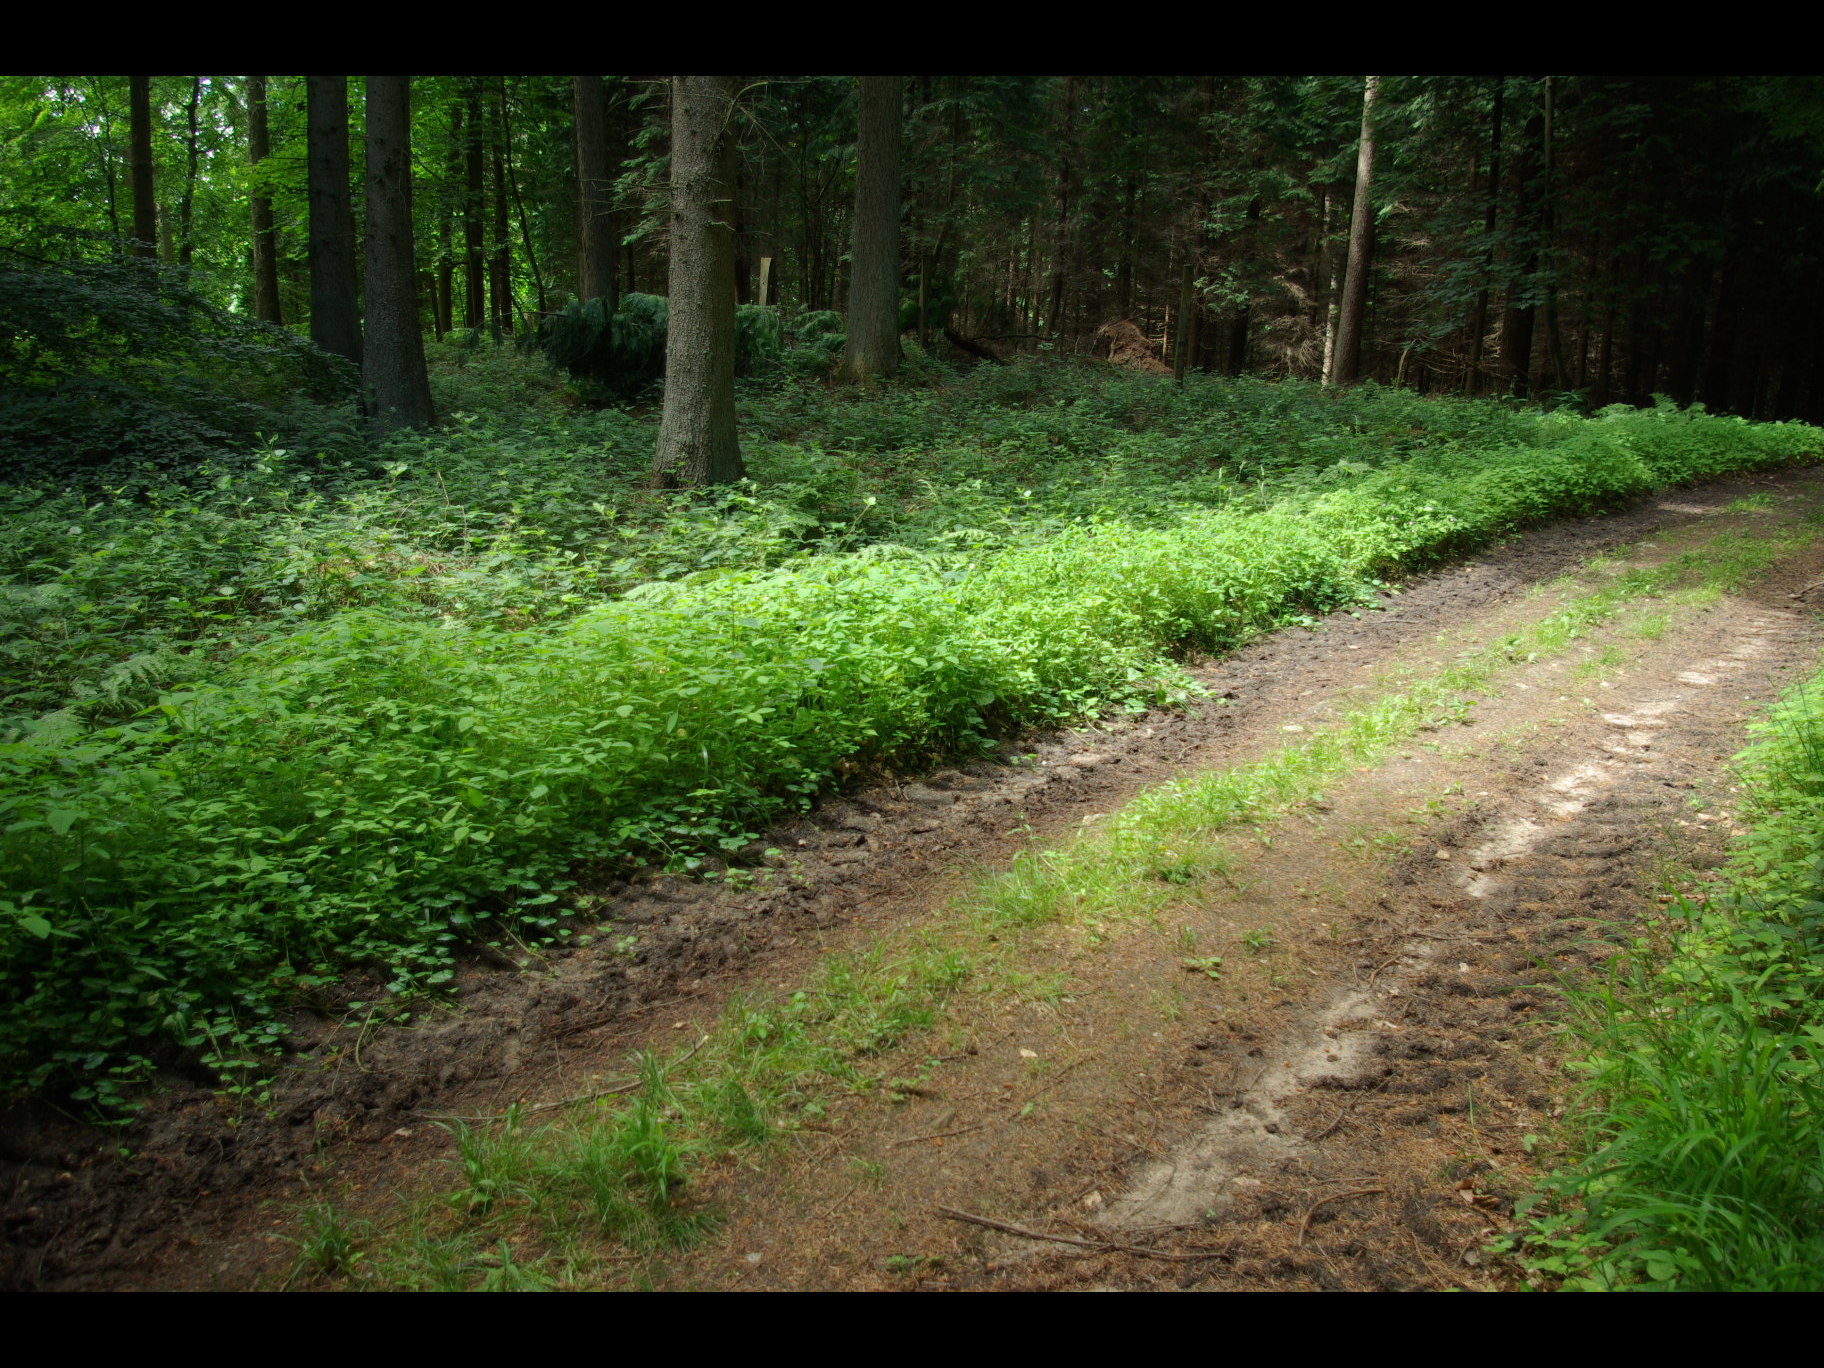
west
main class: Woodland
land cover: Other mixed woodland
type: hemiboreal forest and nemoral coniferous forest and mixed broadleaved-coniferous forest
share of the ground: > 75 %
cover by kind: coniferous forest trees 45 %, broadleaved forest trees 45 %, herbaceous plants 5 %, unconsolidated bare surface 5 %
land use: Forestry
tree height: > 5 m
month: June
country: DE
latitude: 54.3005
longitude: 9.8925
